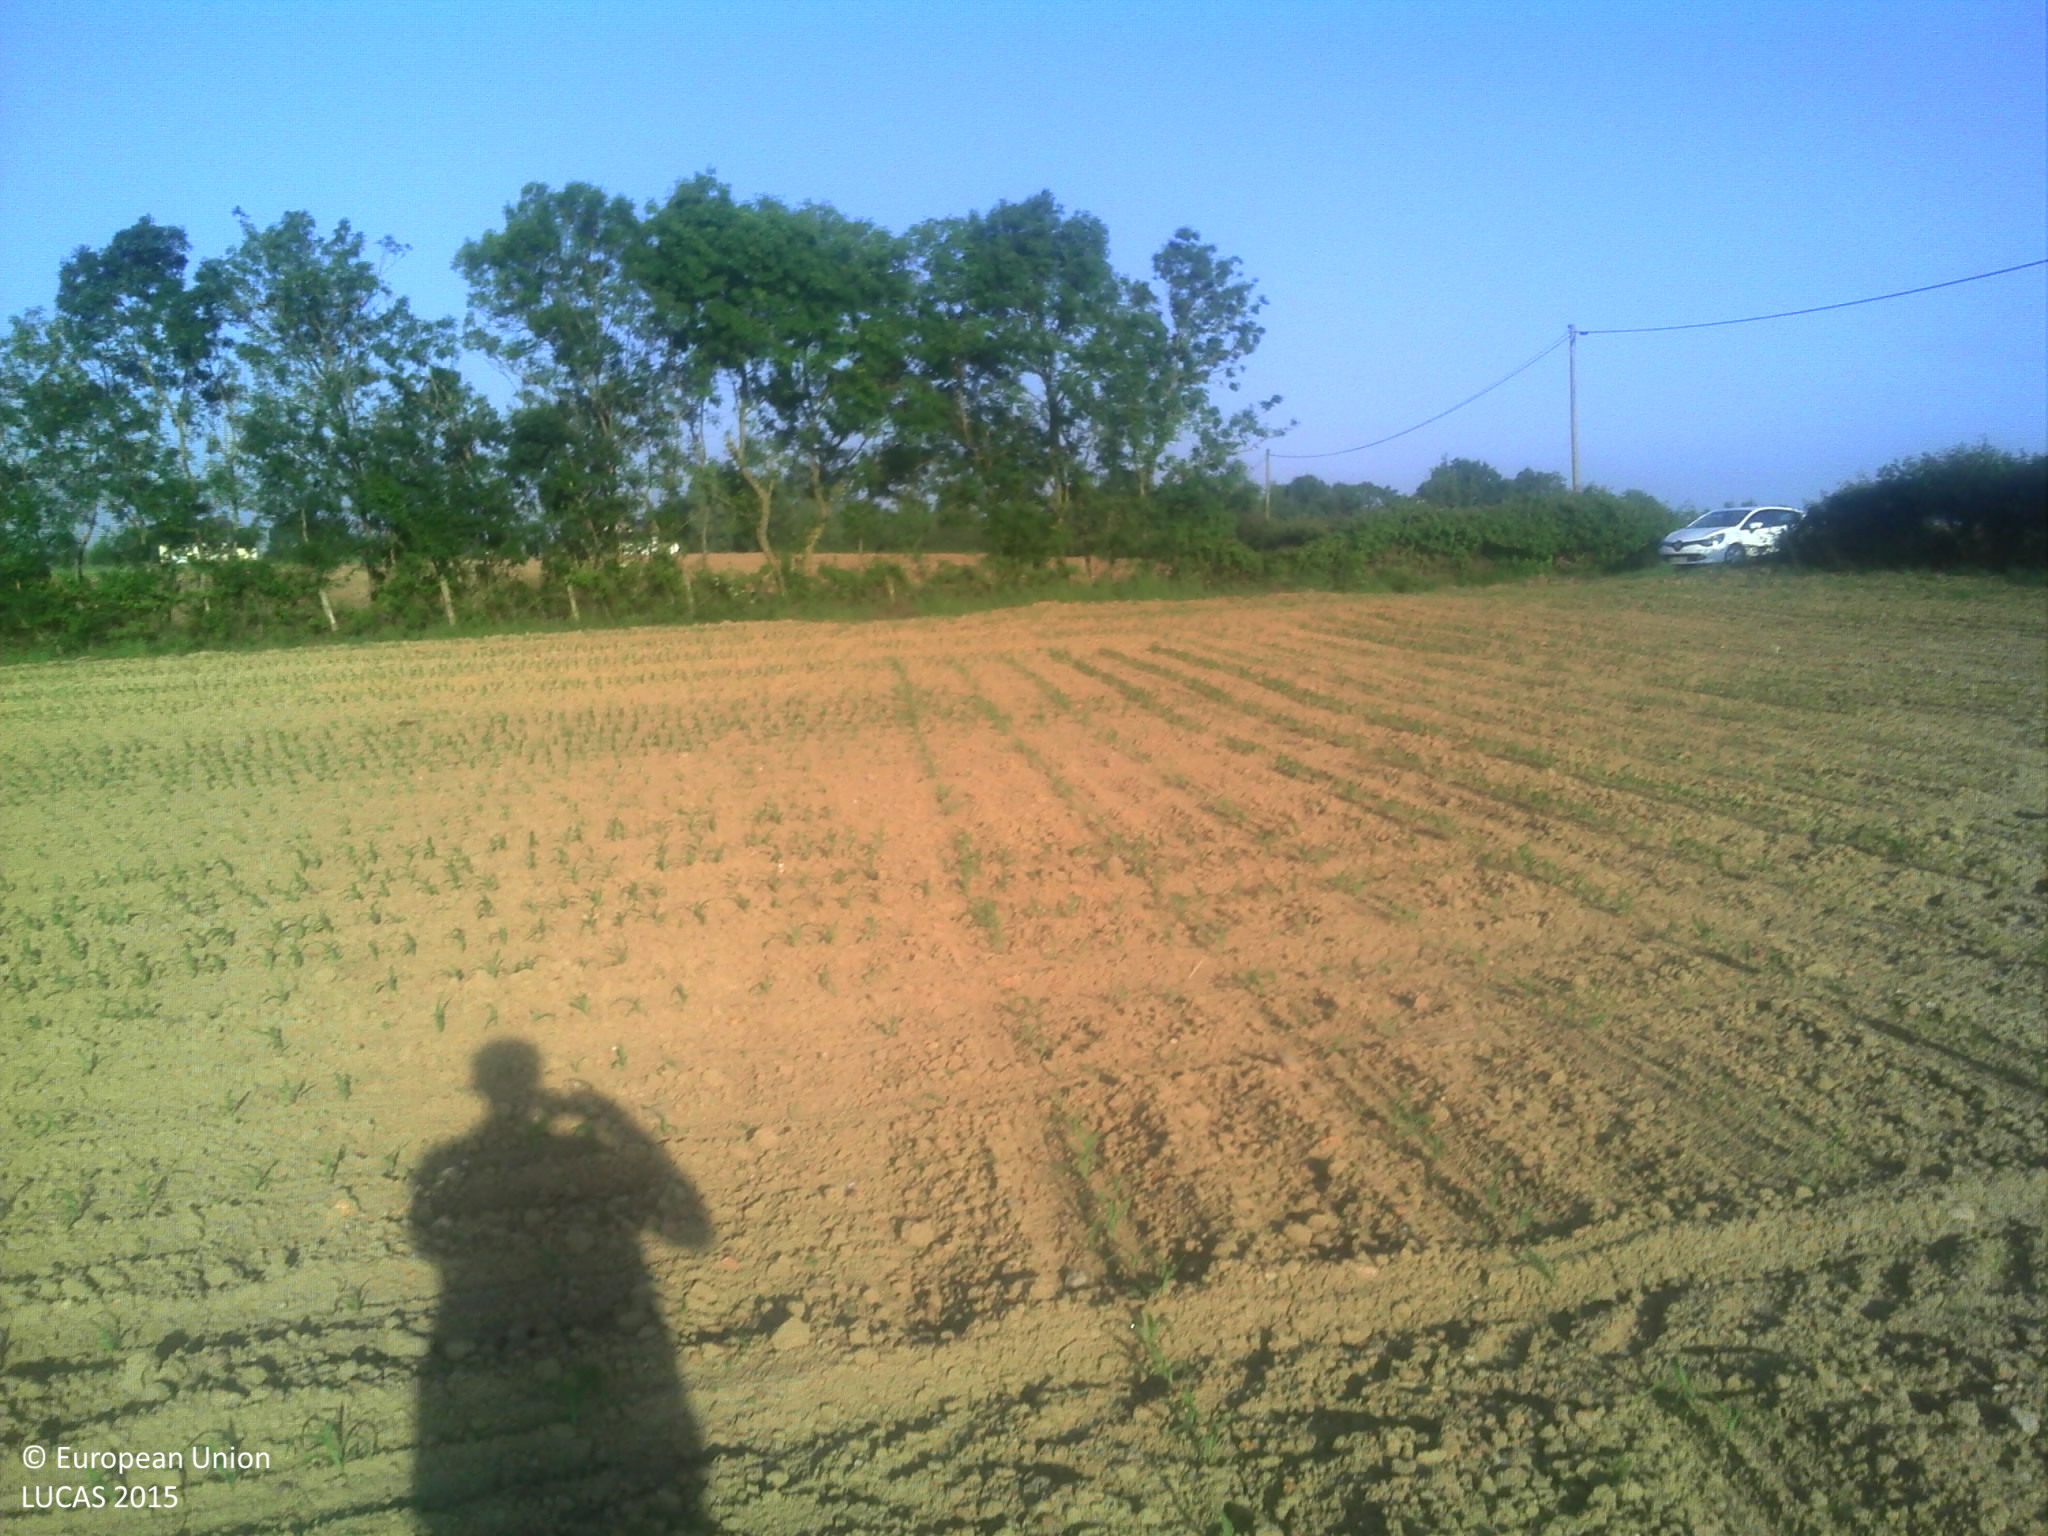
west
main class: Cropland
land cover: Maize
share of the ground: 25 - 50 %
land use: Agriculture (excluding fallow land and kitchen gardens)
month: May
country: FR
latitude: 47.4324
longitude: -1.0277
